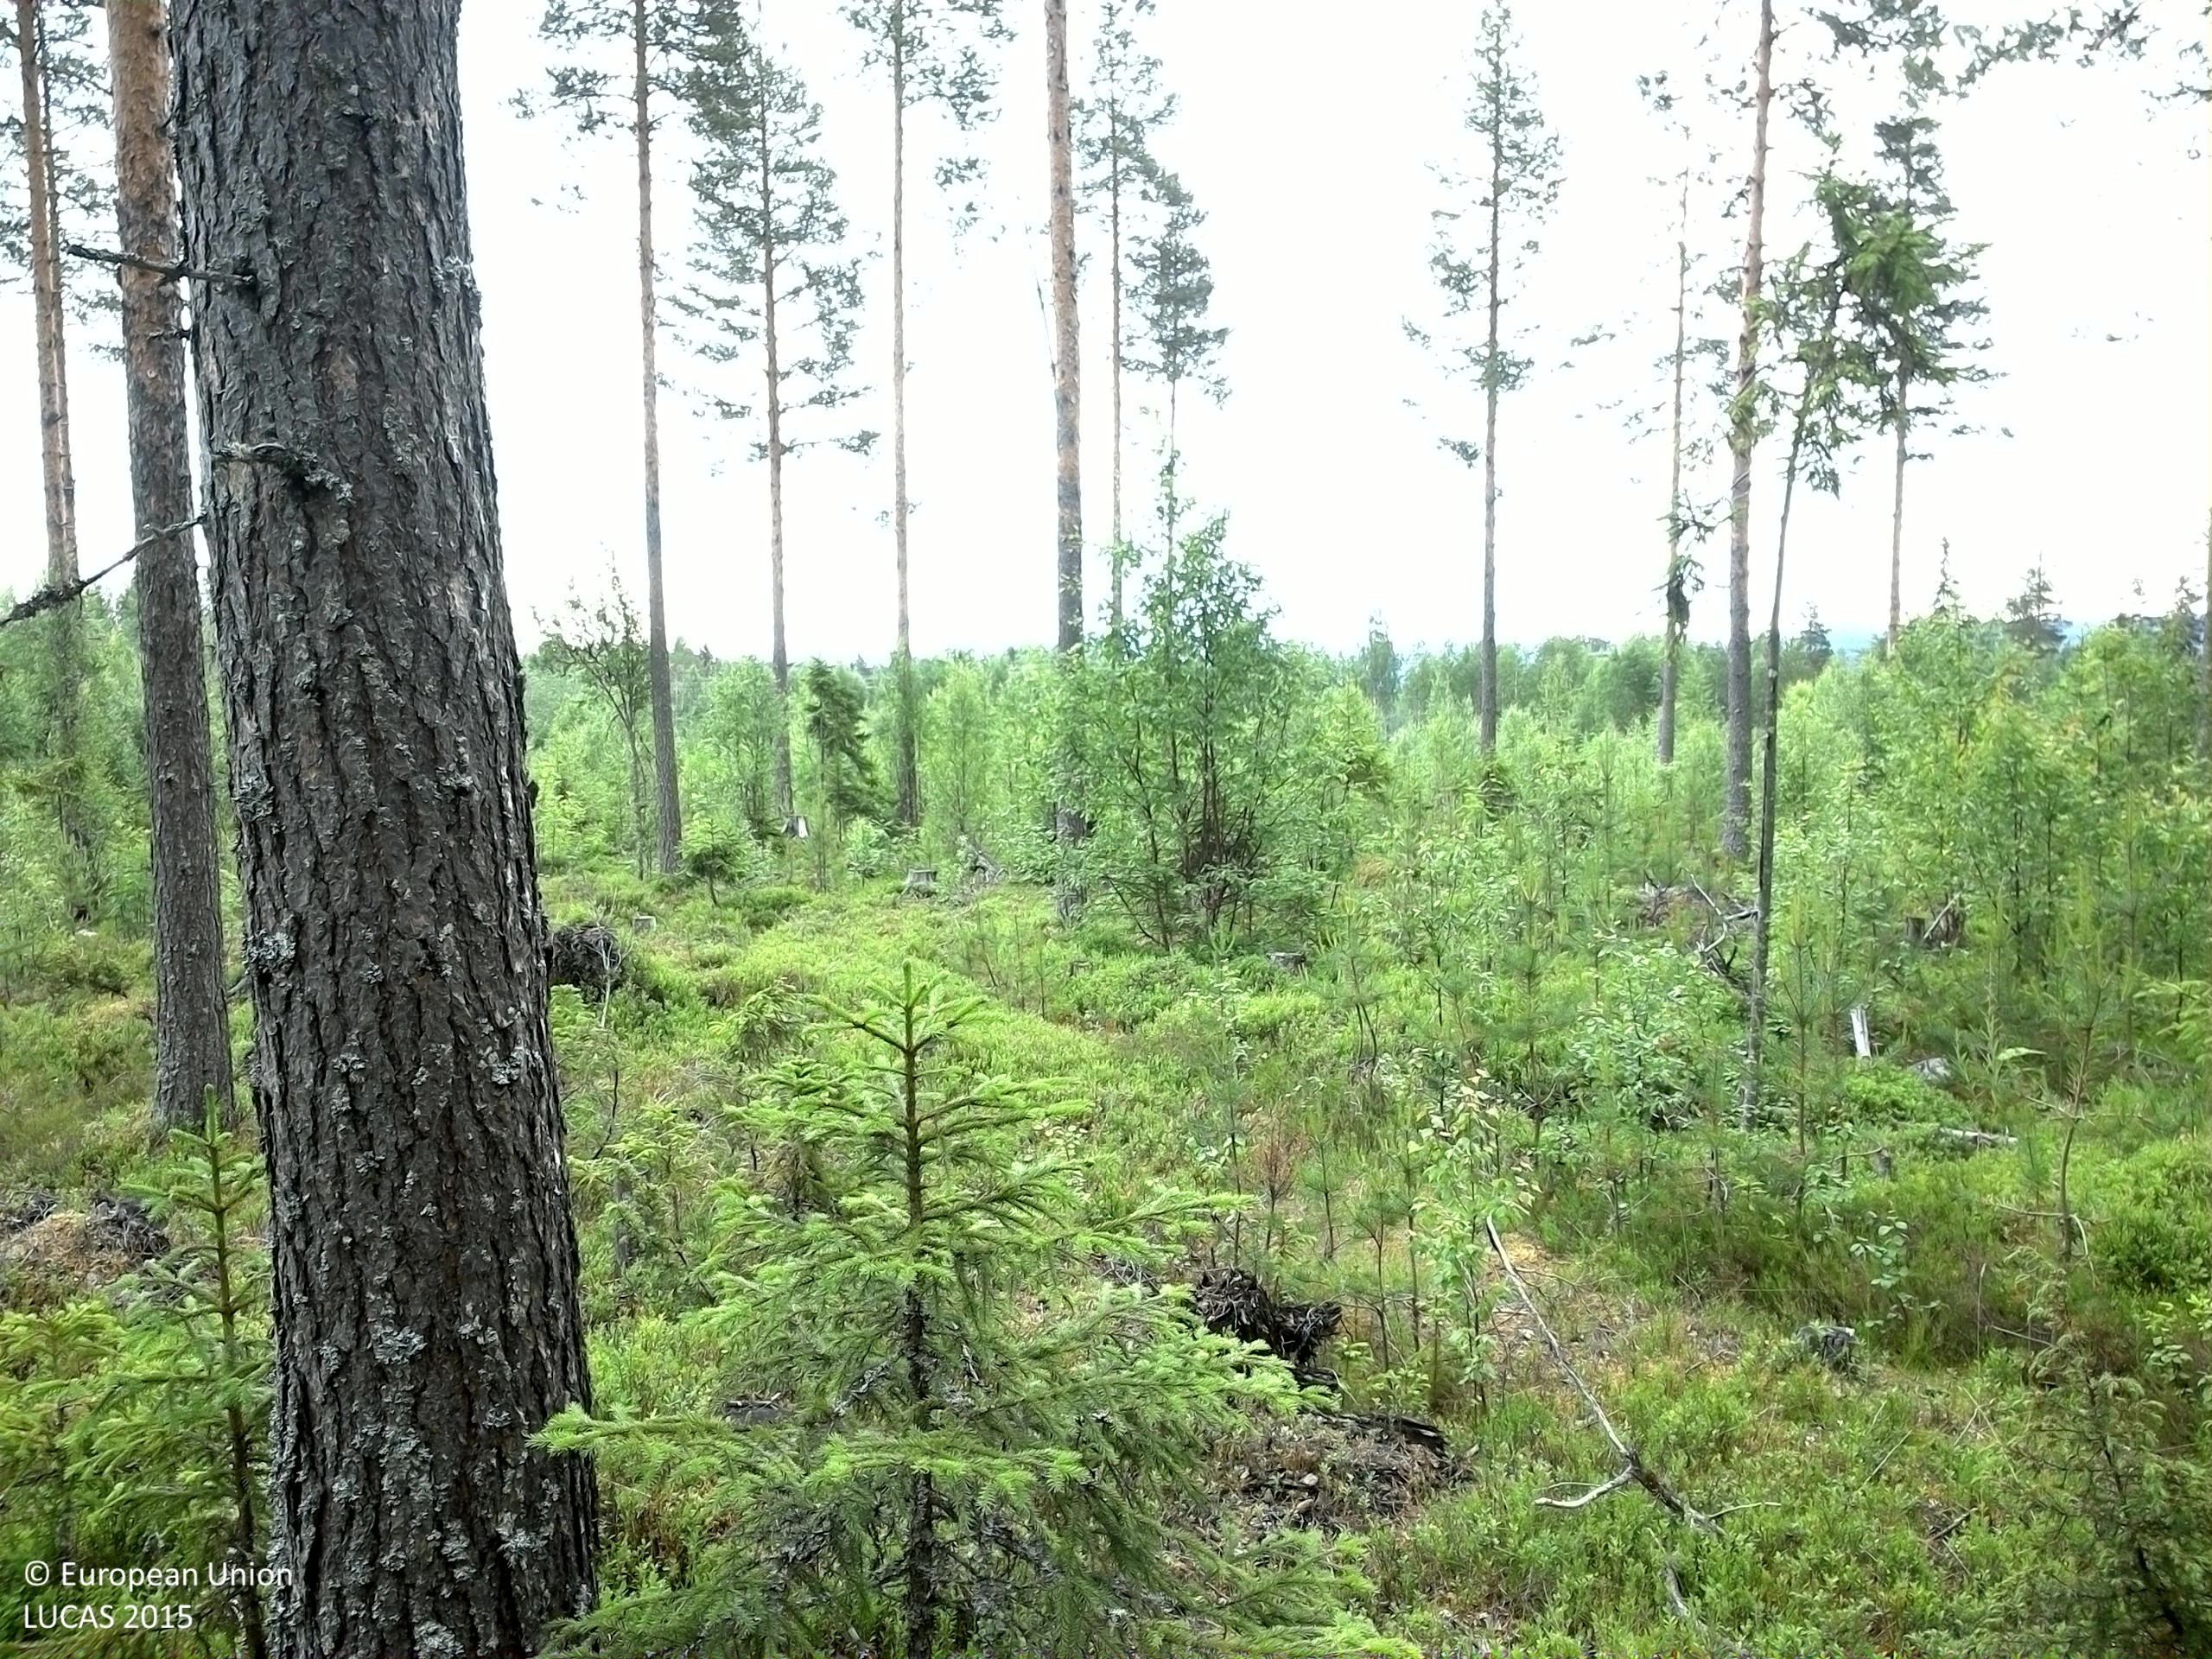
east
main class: Woodland
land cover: Pine dominated mixed woodland
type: boreal forest
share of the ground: 50 - 75 %
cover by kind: coniferous forest trees 35 %, shrubs 30 %, broadleaved forest trees 25 %, herbaceous plants 5 %, lichens and mosses 5 %
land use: Forestry
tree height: > 5 m
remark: Clear cut
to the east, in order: Pine dominated mixed woodland; Tracks; Spruce dominated mixed woodland; Broadleaved woodland; Spruce dominated mixed woodland; Rivers and streams; Spruce dominated mixed woodland; Grassland without tree/shrub cover; Electric lines
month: July
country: SE
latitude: 63.5328
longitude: 18.5230
